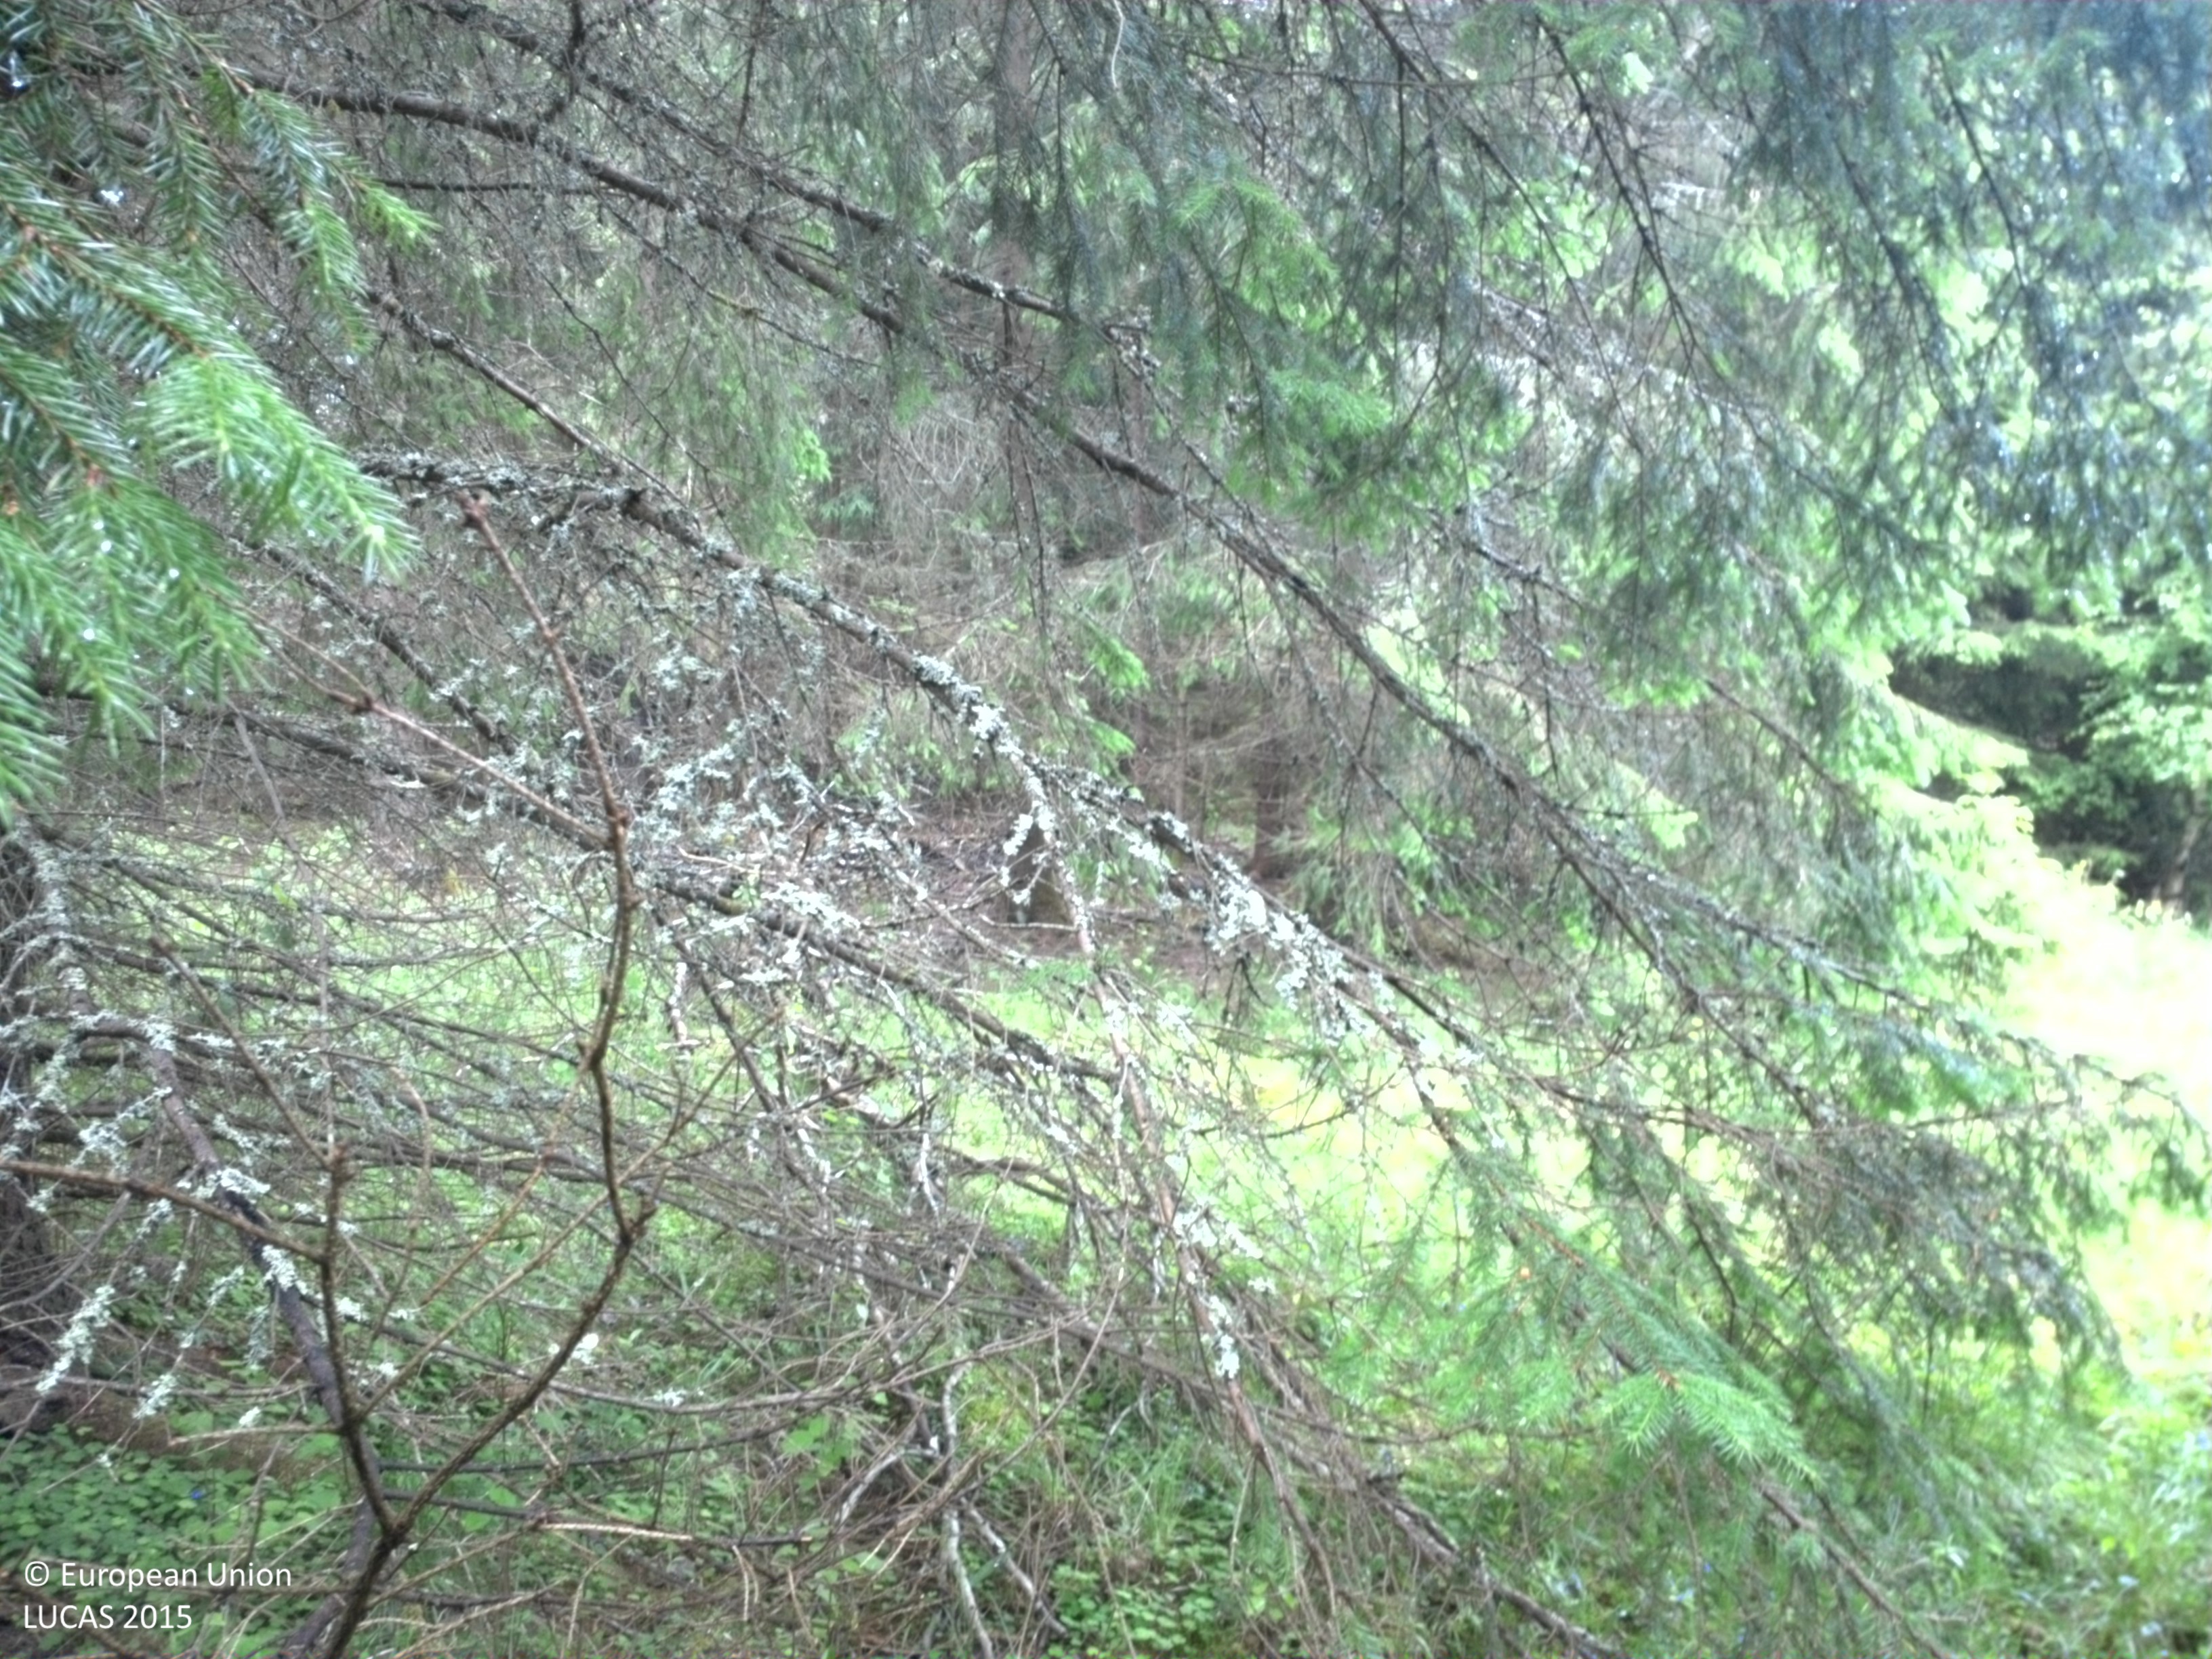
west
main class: Woodland
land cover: Spruce dominated mixed woodland
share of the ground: 50 - 75 %
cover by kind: coniferous forest trees 40 %, herbaceous plants 30 %, broadleaved forest trees 20 %, lichens and mosses 10 %
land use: Forestry
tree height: > 5 m
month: June
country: SE
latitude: 58.5848
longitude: 15.7220
